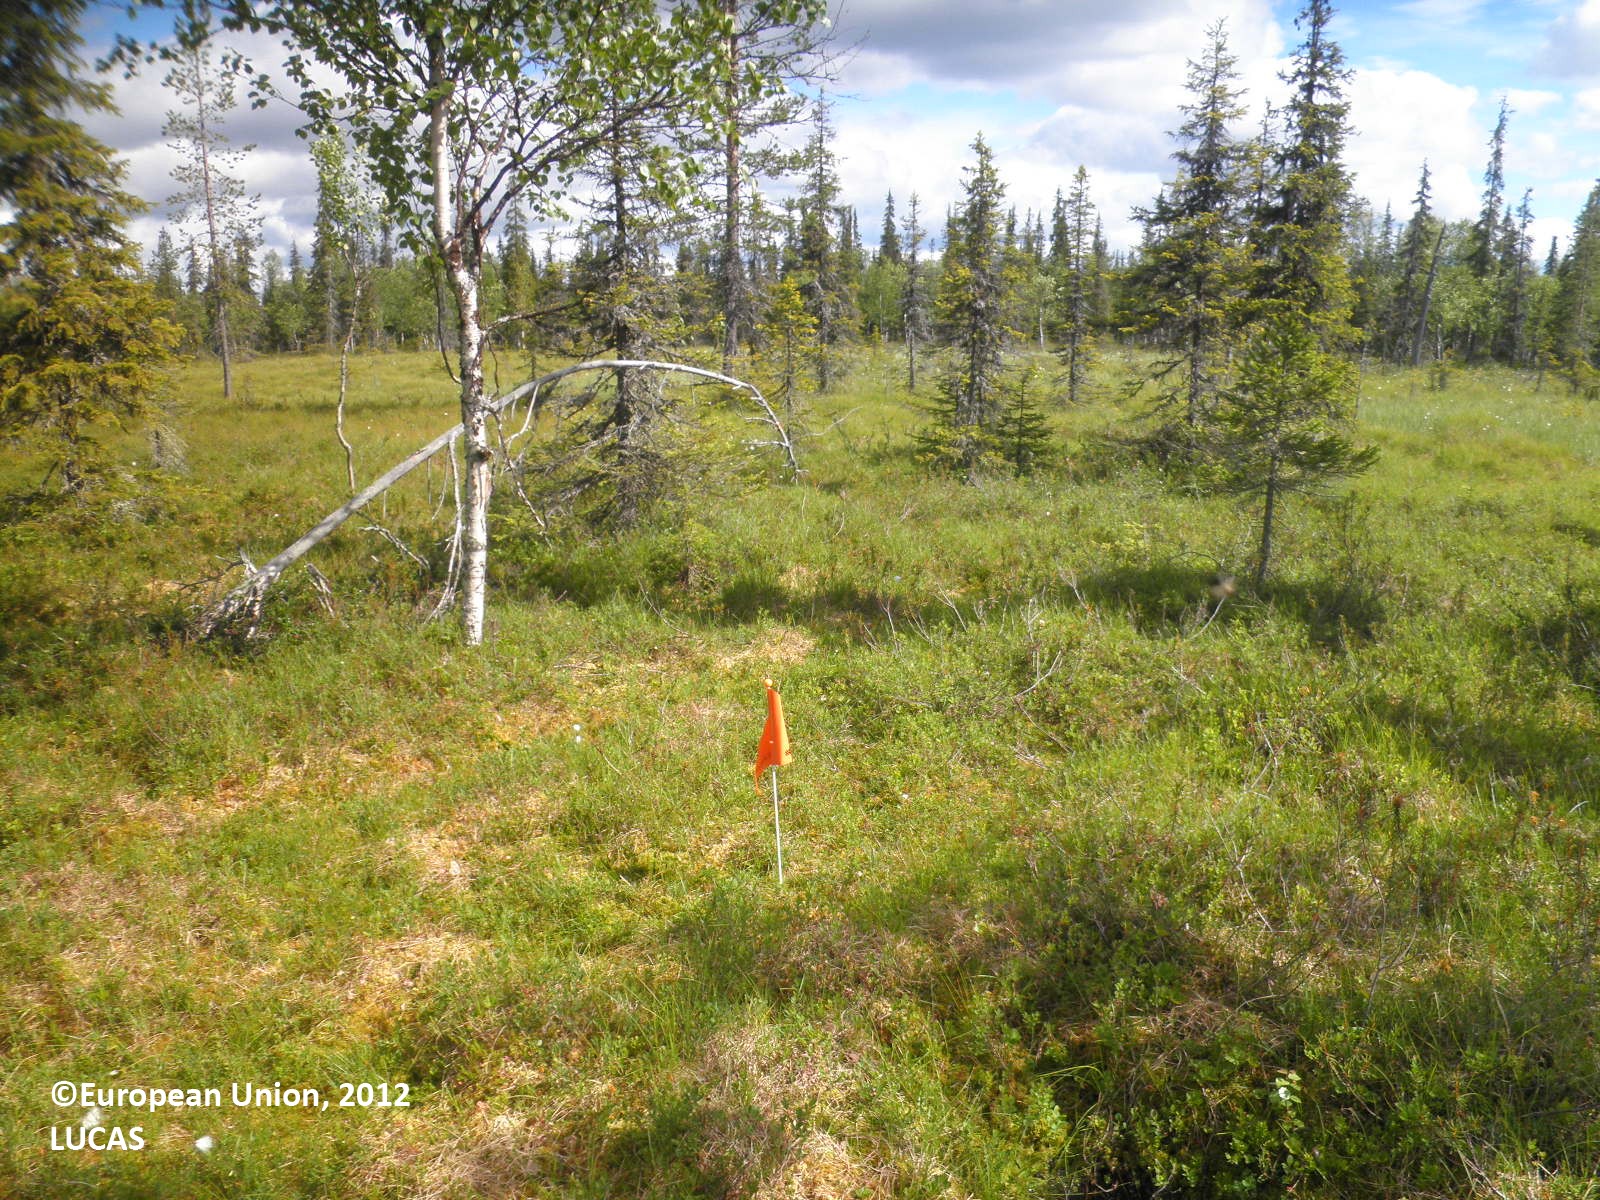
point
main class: Woodland
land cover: Spruce dominated mixed woodland
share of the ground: 10 - 25 %
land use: Forestry
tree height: > 5 m
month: July
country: FI
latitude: 67.8351
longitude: 26.3319
